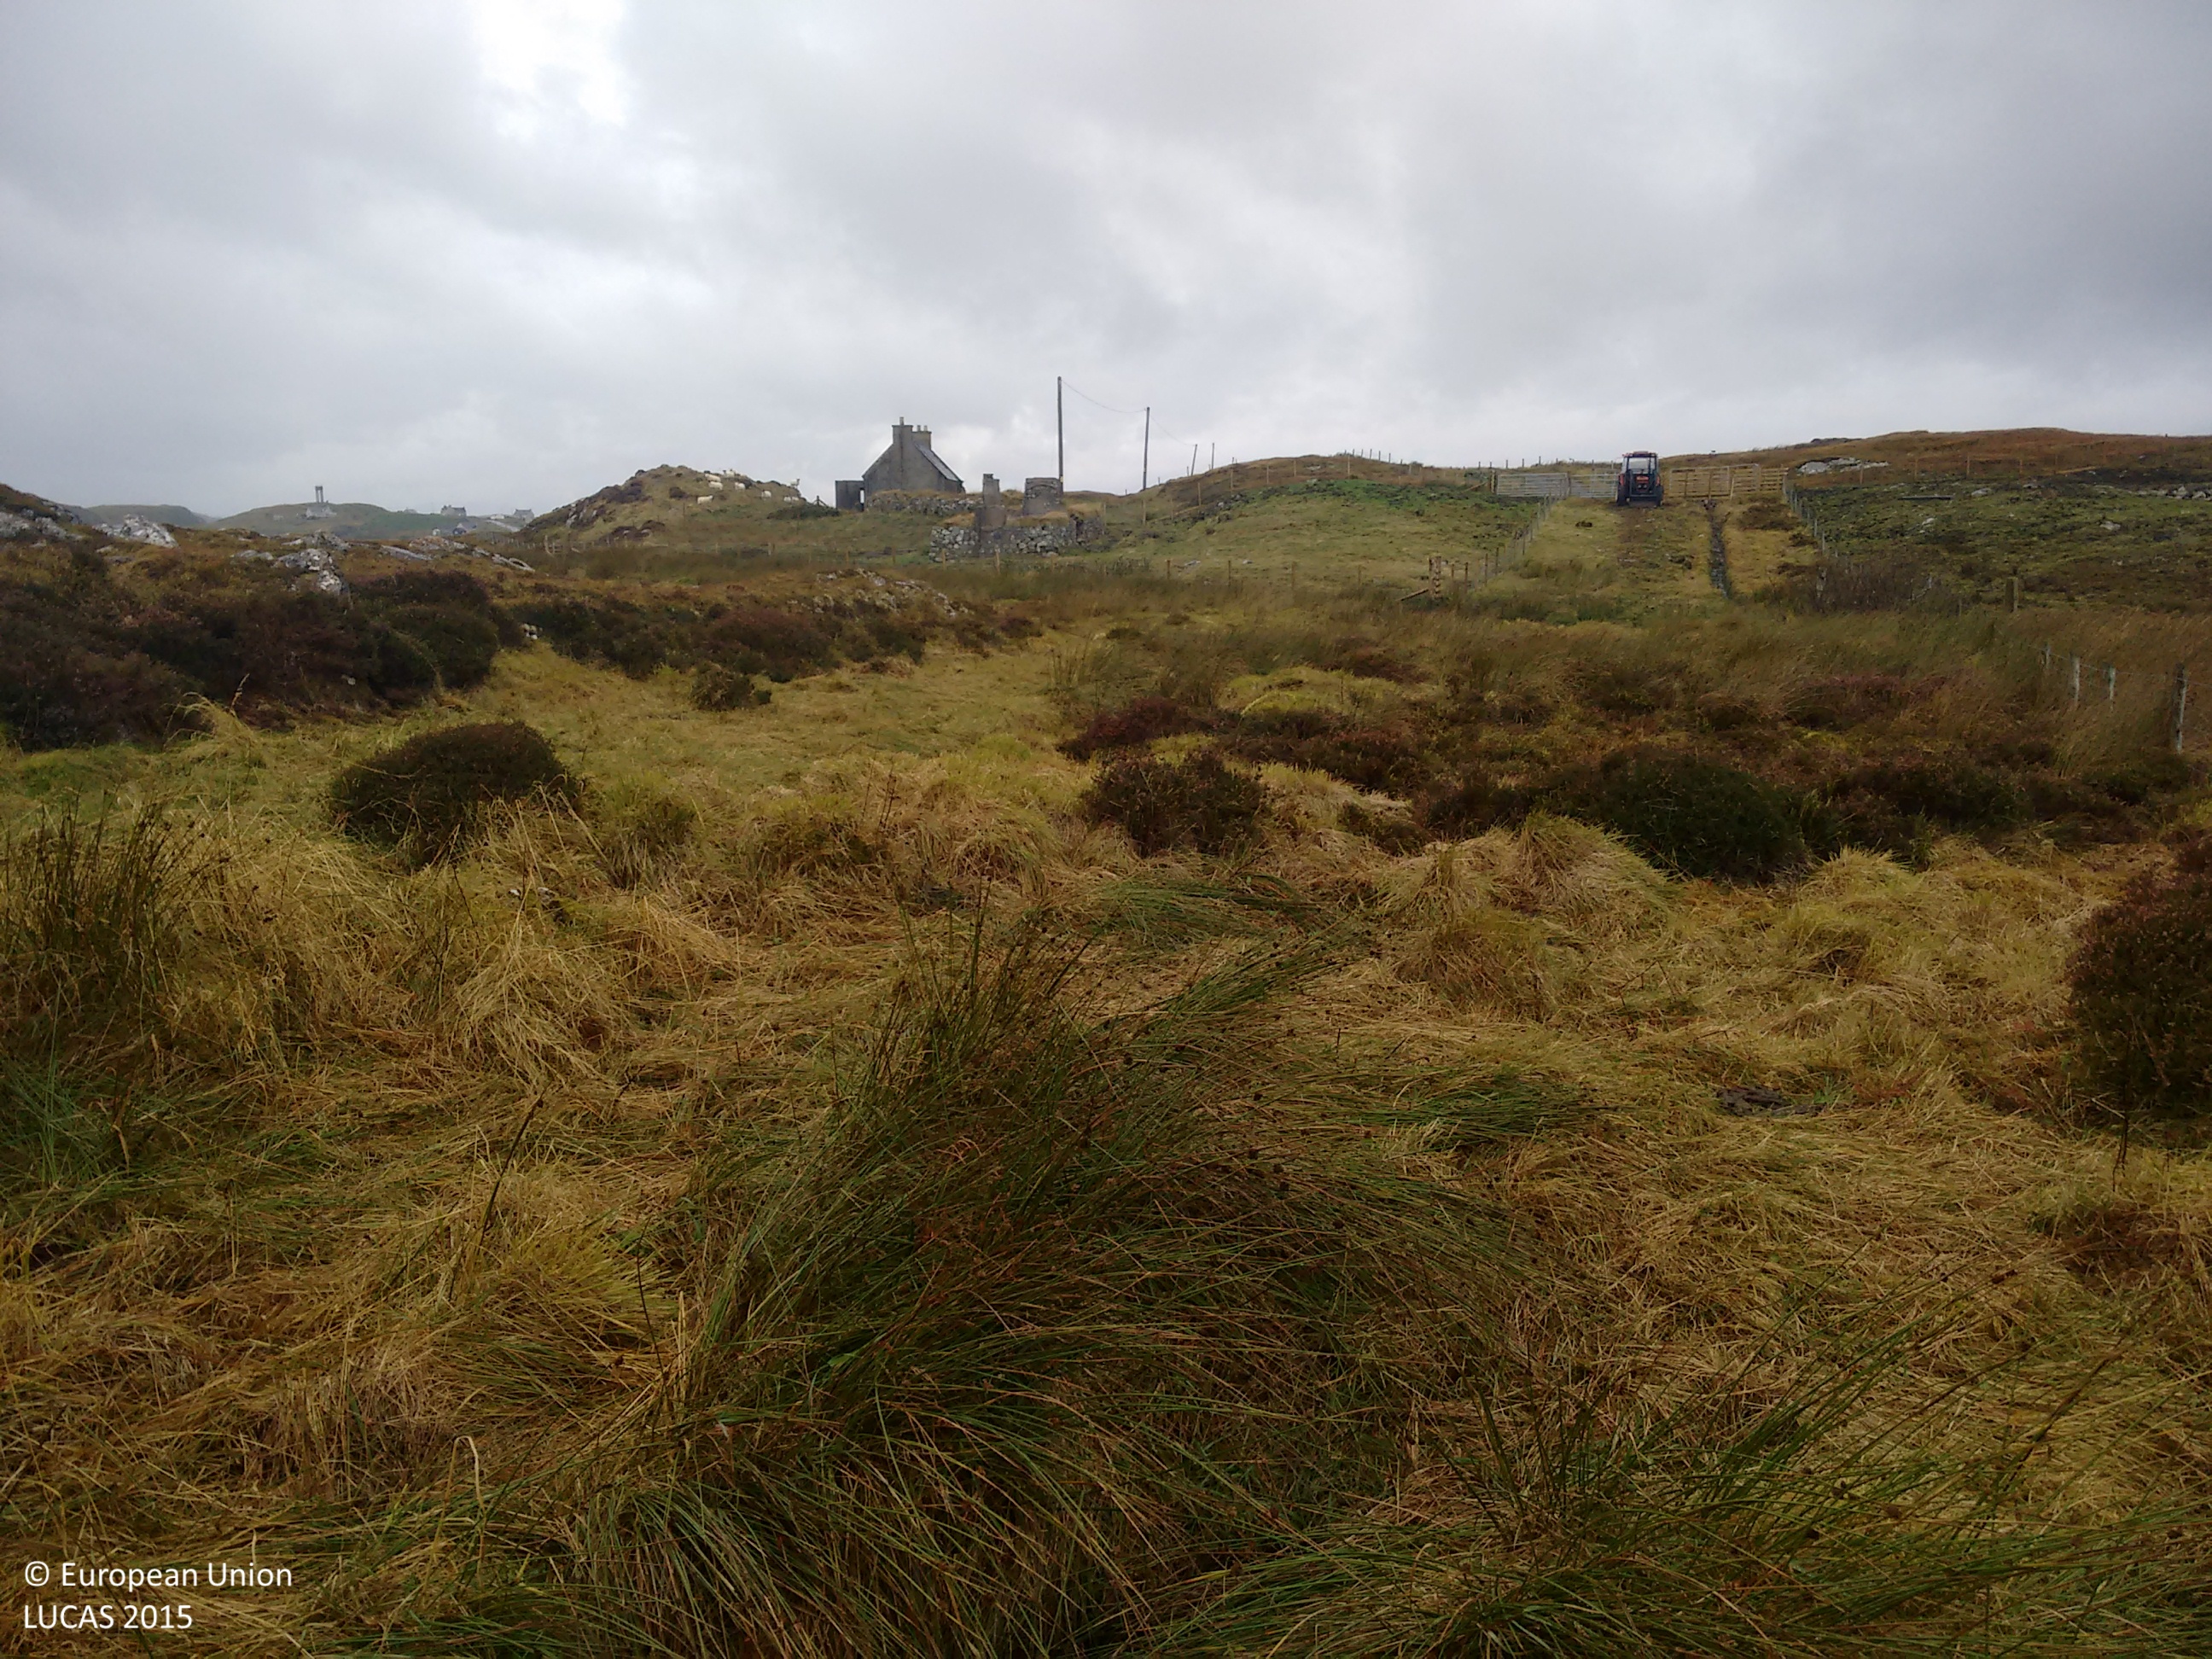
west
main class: Shrubland
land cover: Shrubland without tree cover
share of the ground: > 75 %
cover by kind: herbaceous plants 60 %, shrubs 40 %
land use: Agriculture (excluding fallow land and kitchen gardens)
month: October
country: GB
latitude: 58.1419
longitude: -6.3915
